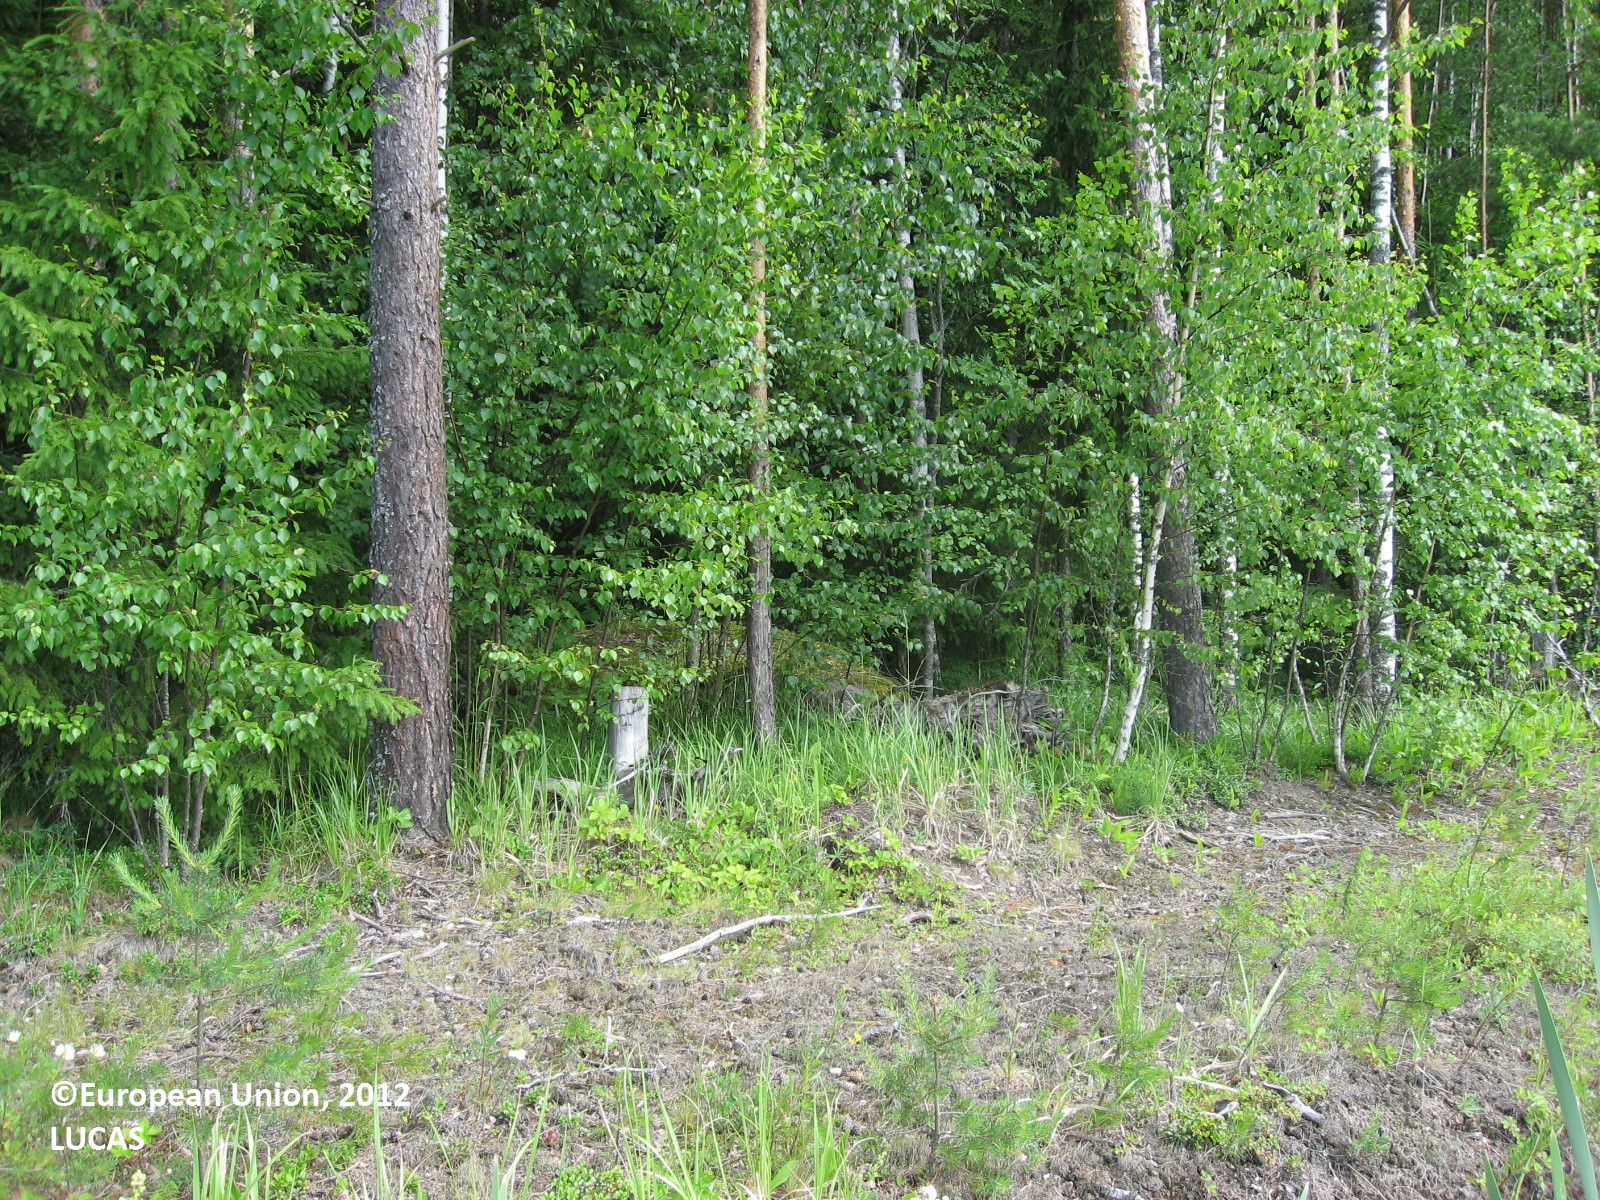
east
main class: Grassland
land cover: Spontaneously vegetated surfaces
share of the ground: < 10 %
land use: Fallow land
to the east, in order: Spontaneously vegetated surfaces; Grass margins; Ditches and canals; Grass margins; Pine dominated mixed woodland; Spruce dominated mixed woodland; Spruce dominated coniferous woodland; Ditches and canals; Spruce dominated mixed woodland; Ditches and canals; Spruce dominated mixed woodland; Paved roads, cycling and walking lanes; Spruce dominated mixed woodland; Tracks; Pine dominated mixed woodland
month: June
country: FI
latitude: 60.7964
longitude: 26.4116
